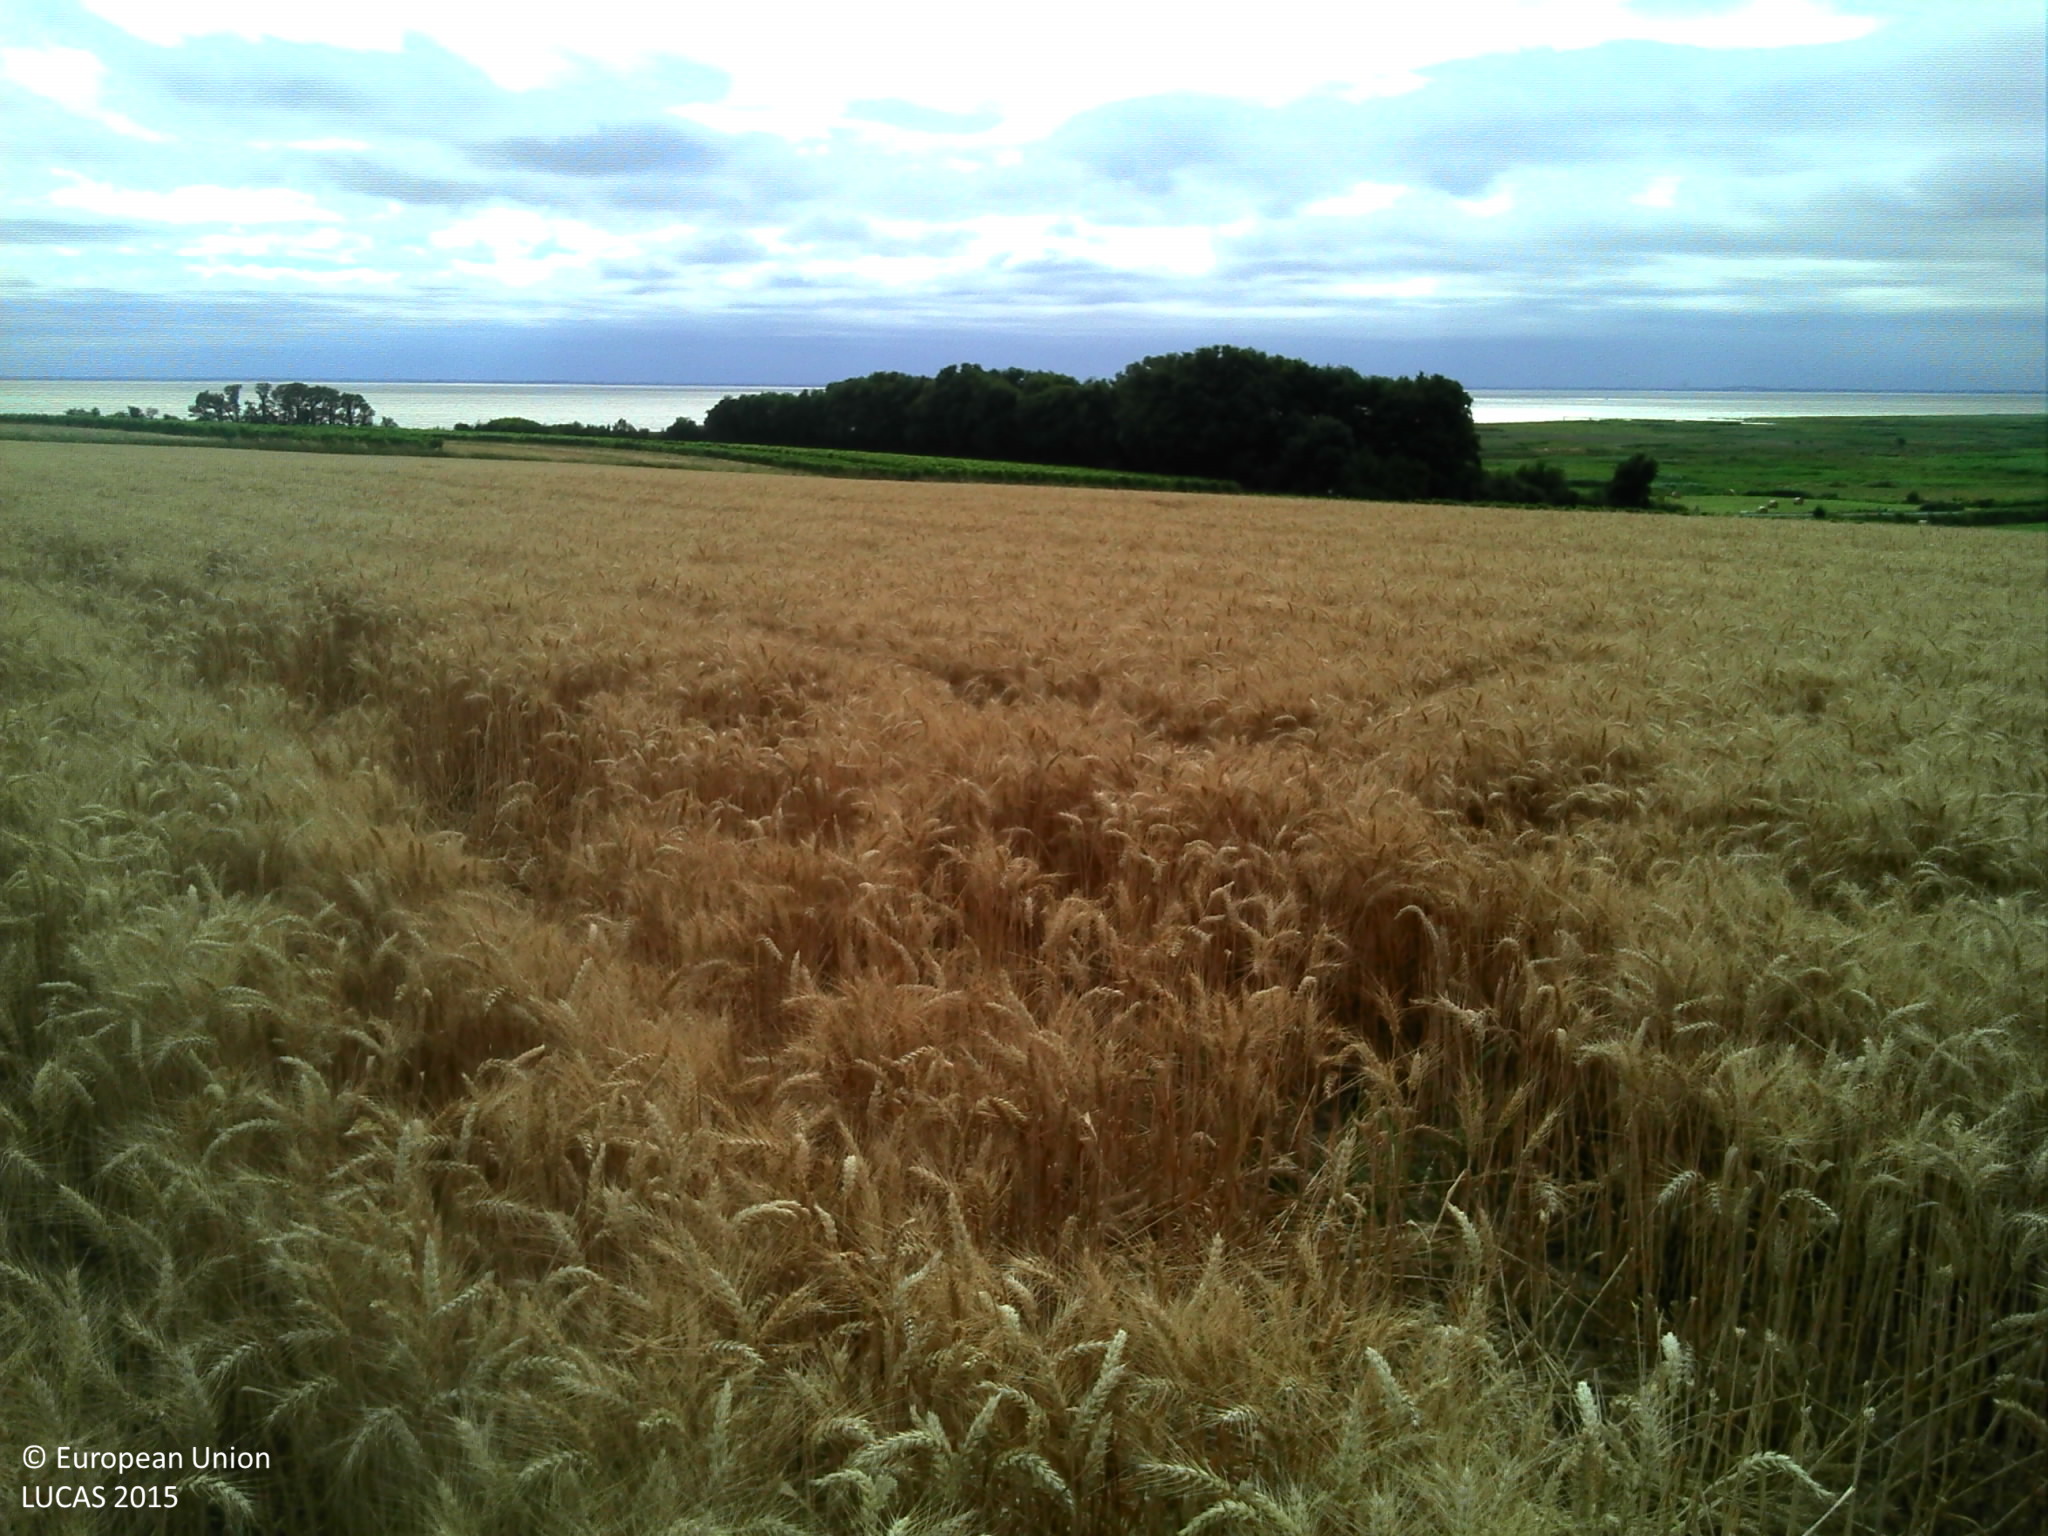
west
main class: Cropland
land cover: Durum wheat
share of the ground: > 75 %
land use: Agriculture (excluding fallow land and kitchen gardens)
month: July
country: FR
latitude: 45.5079
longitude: -0.8405
